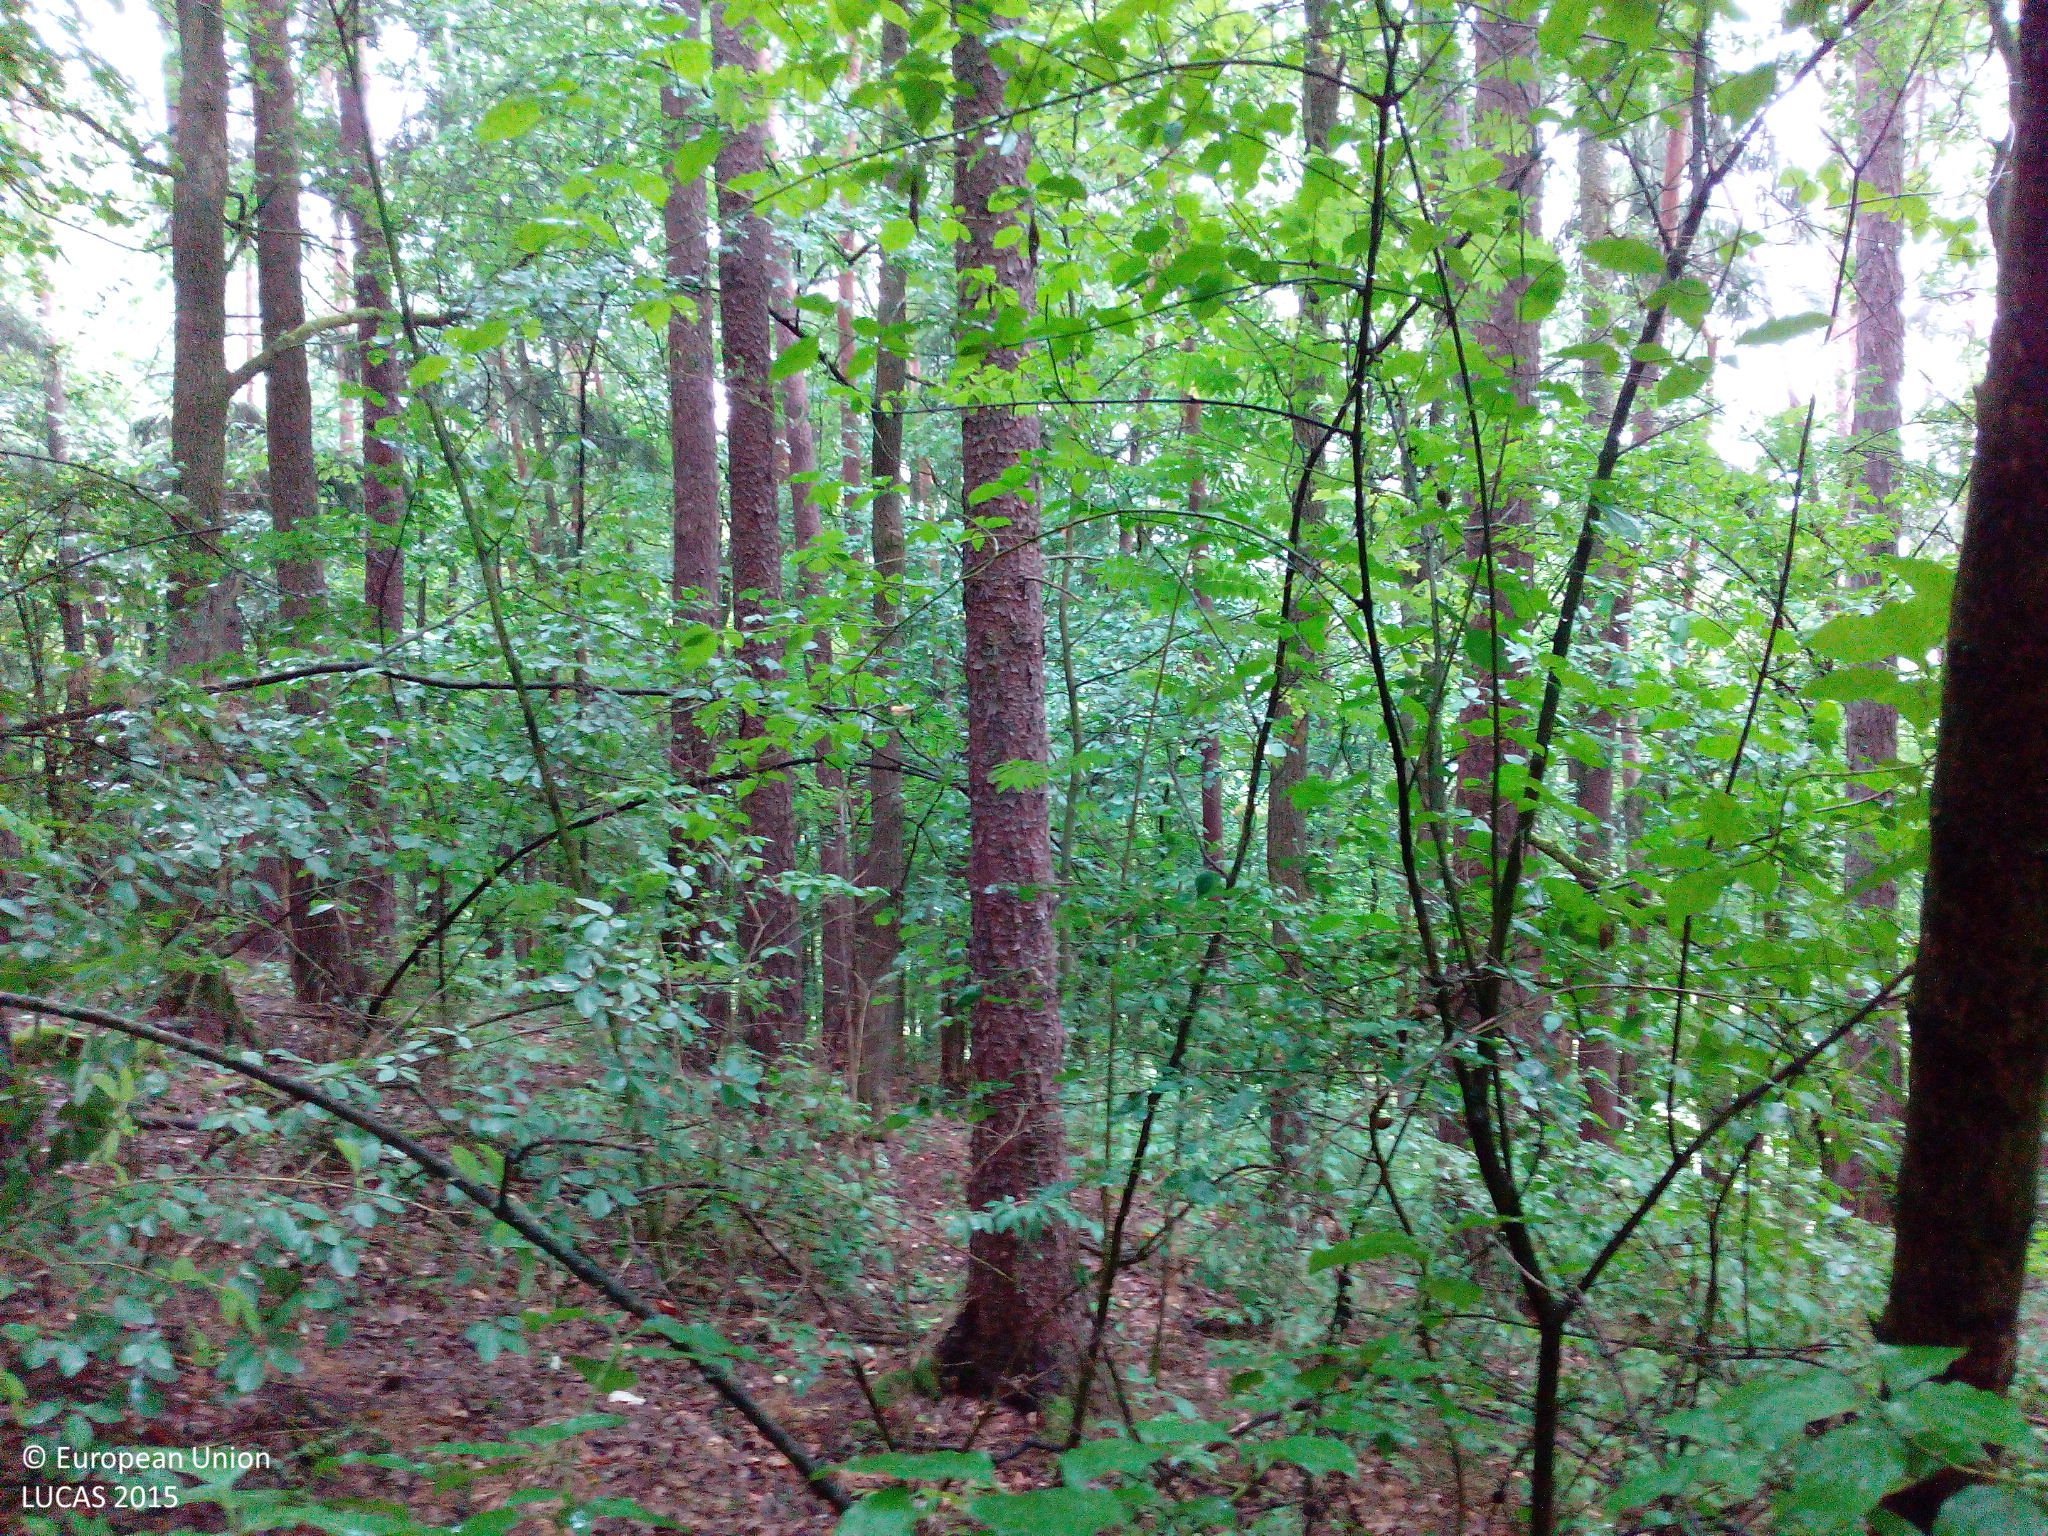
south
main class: Woodland
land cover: Pine dominated mixed woodland
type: hemiboreal forest and nemoral coniferous forest and mixed broadleaved-coniferous forest
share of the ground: > 75 %
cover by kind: coniferous forest trees 65 %, broadleaved forest trees 30 %, unconsolidated bare surface 5 %
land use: Forestry
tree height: > 5 m
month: June
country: DE
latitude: 50.1021
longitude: 11.5235
